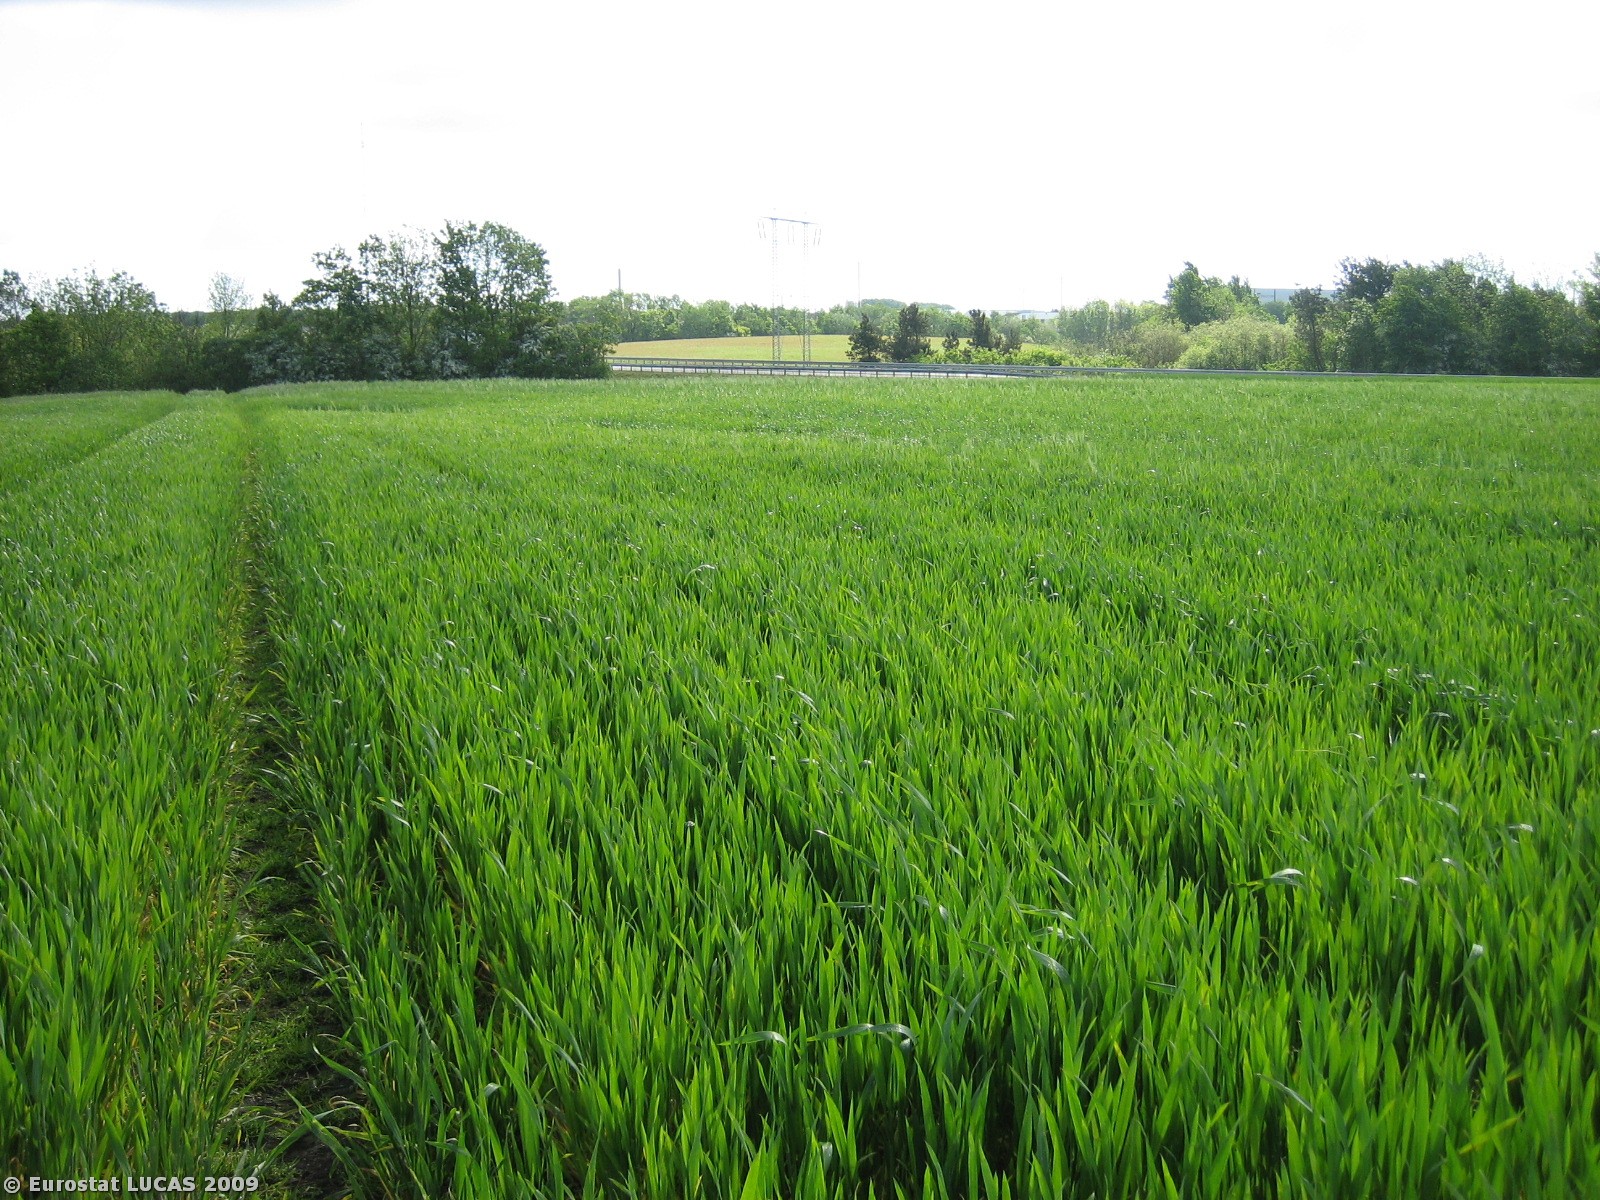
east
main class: Cropland
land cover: Barley
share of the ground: > 75 %
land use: Agriculture (excluding fallow land and kitchen gardens)
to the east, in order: Barley; Shrubland without tree cover; Grassland without tree/shrub cover; Paved roads, cycling and walking lanes; Grass margins; Tracks; Grassland without tree/shrub cover; Electric lines; Grassland without tree/shrub cover; Ditches and canals; Grassland without tree/shrub cover; Spontaneously vegetated surfaces
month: May
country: DK
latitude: 56.1293
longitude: 8.9233
